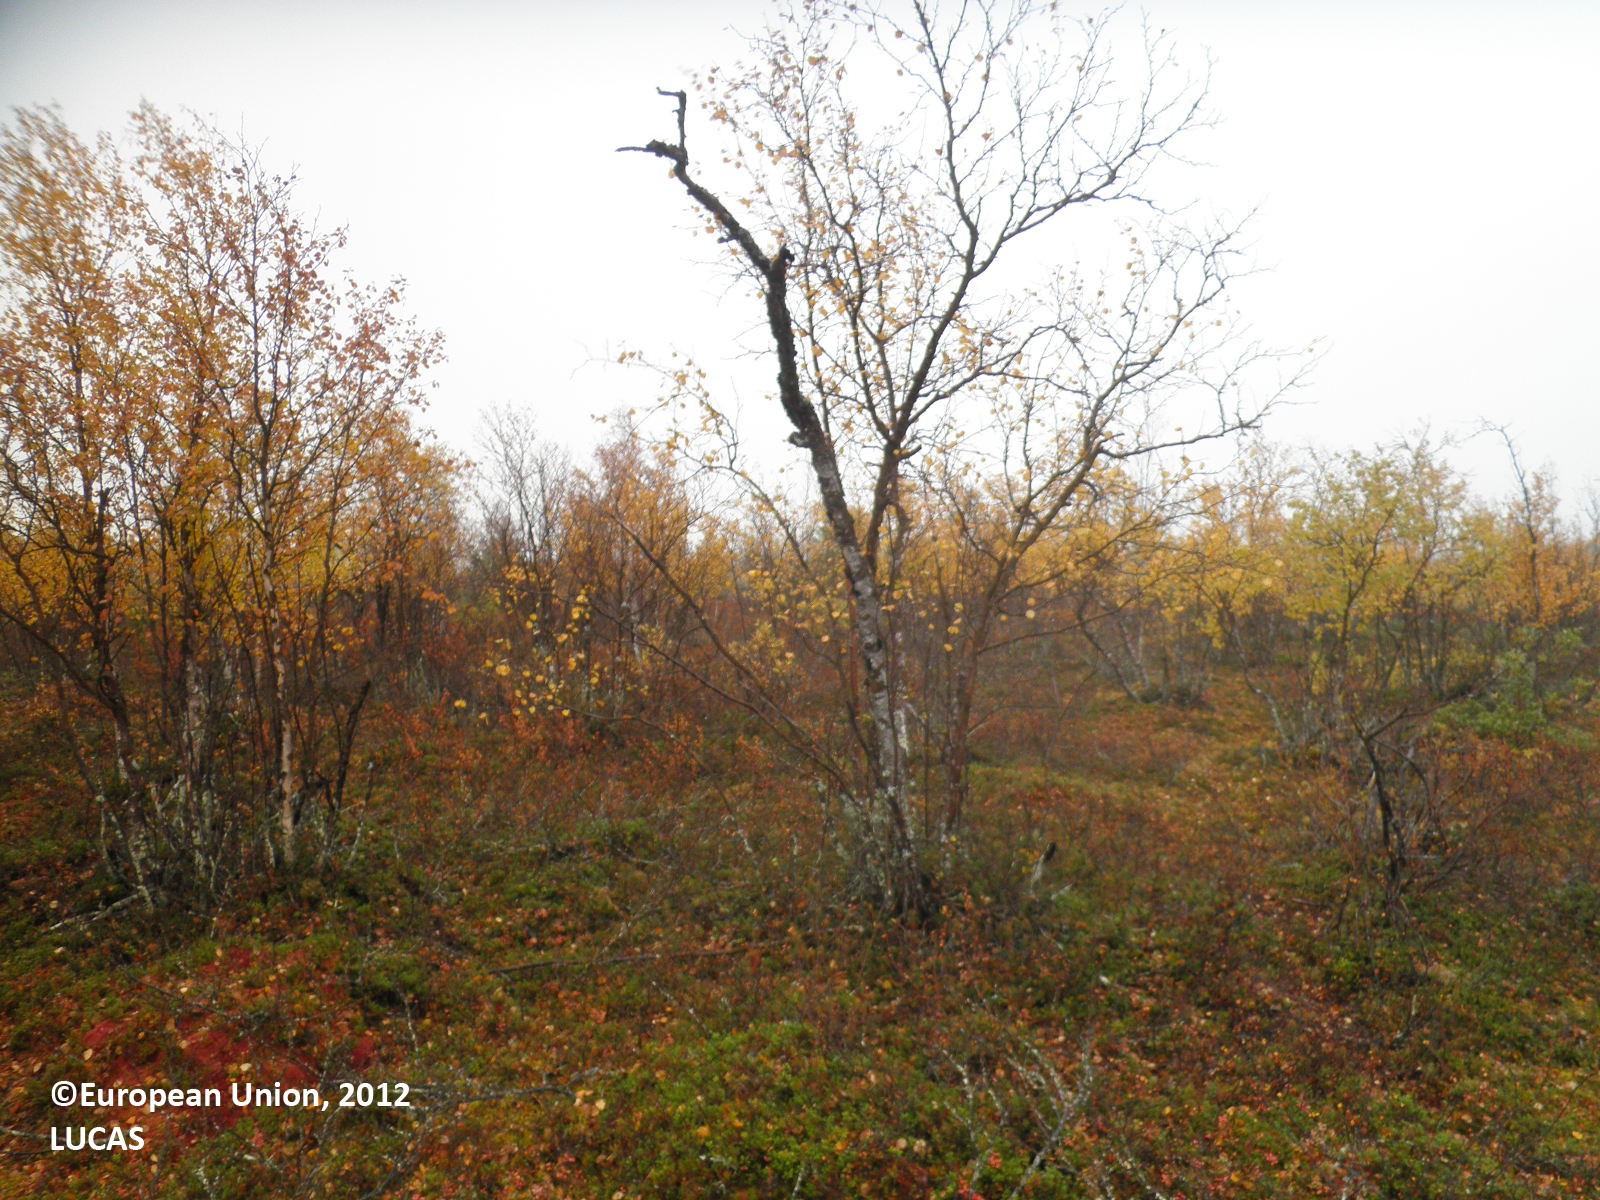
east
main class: Woodland
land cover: Broadleaved woodland
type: boreal forest
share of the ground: 50 - 75 %
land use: Forestry
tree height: > 5 m
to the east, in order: Broadleaved woodland; Shrubland with sparse tree cover; Peatbogs
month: September
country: FI
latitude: 68.4454
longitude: 22.7017
